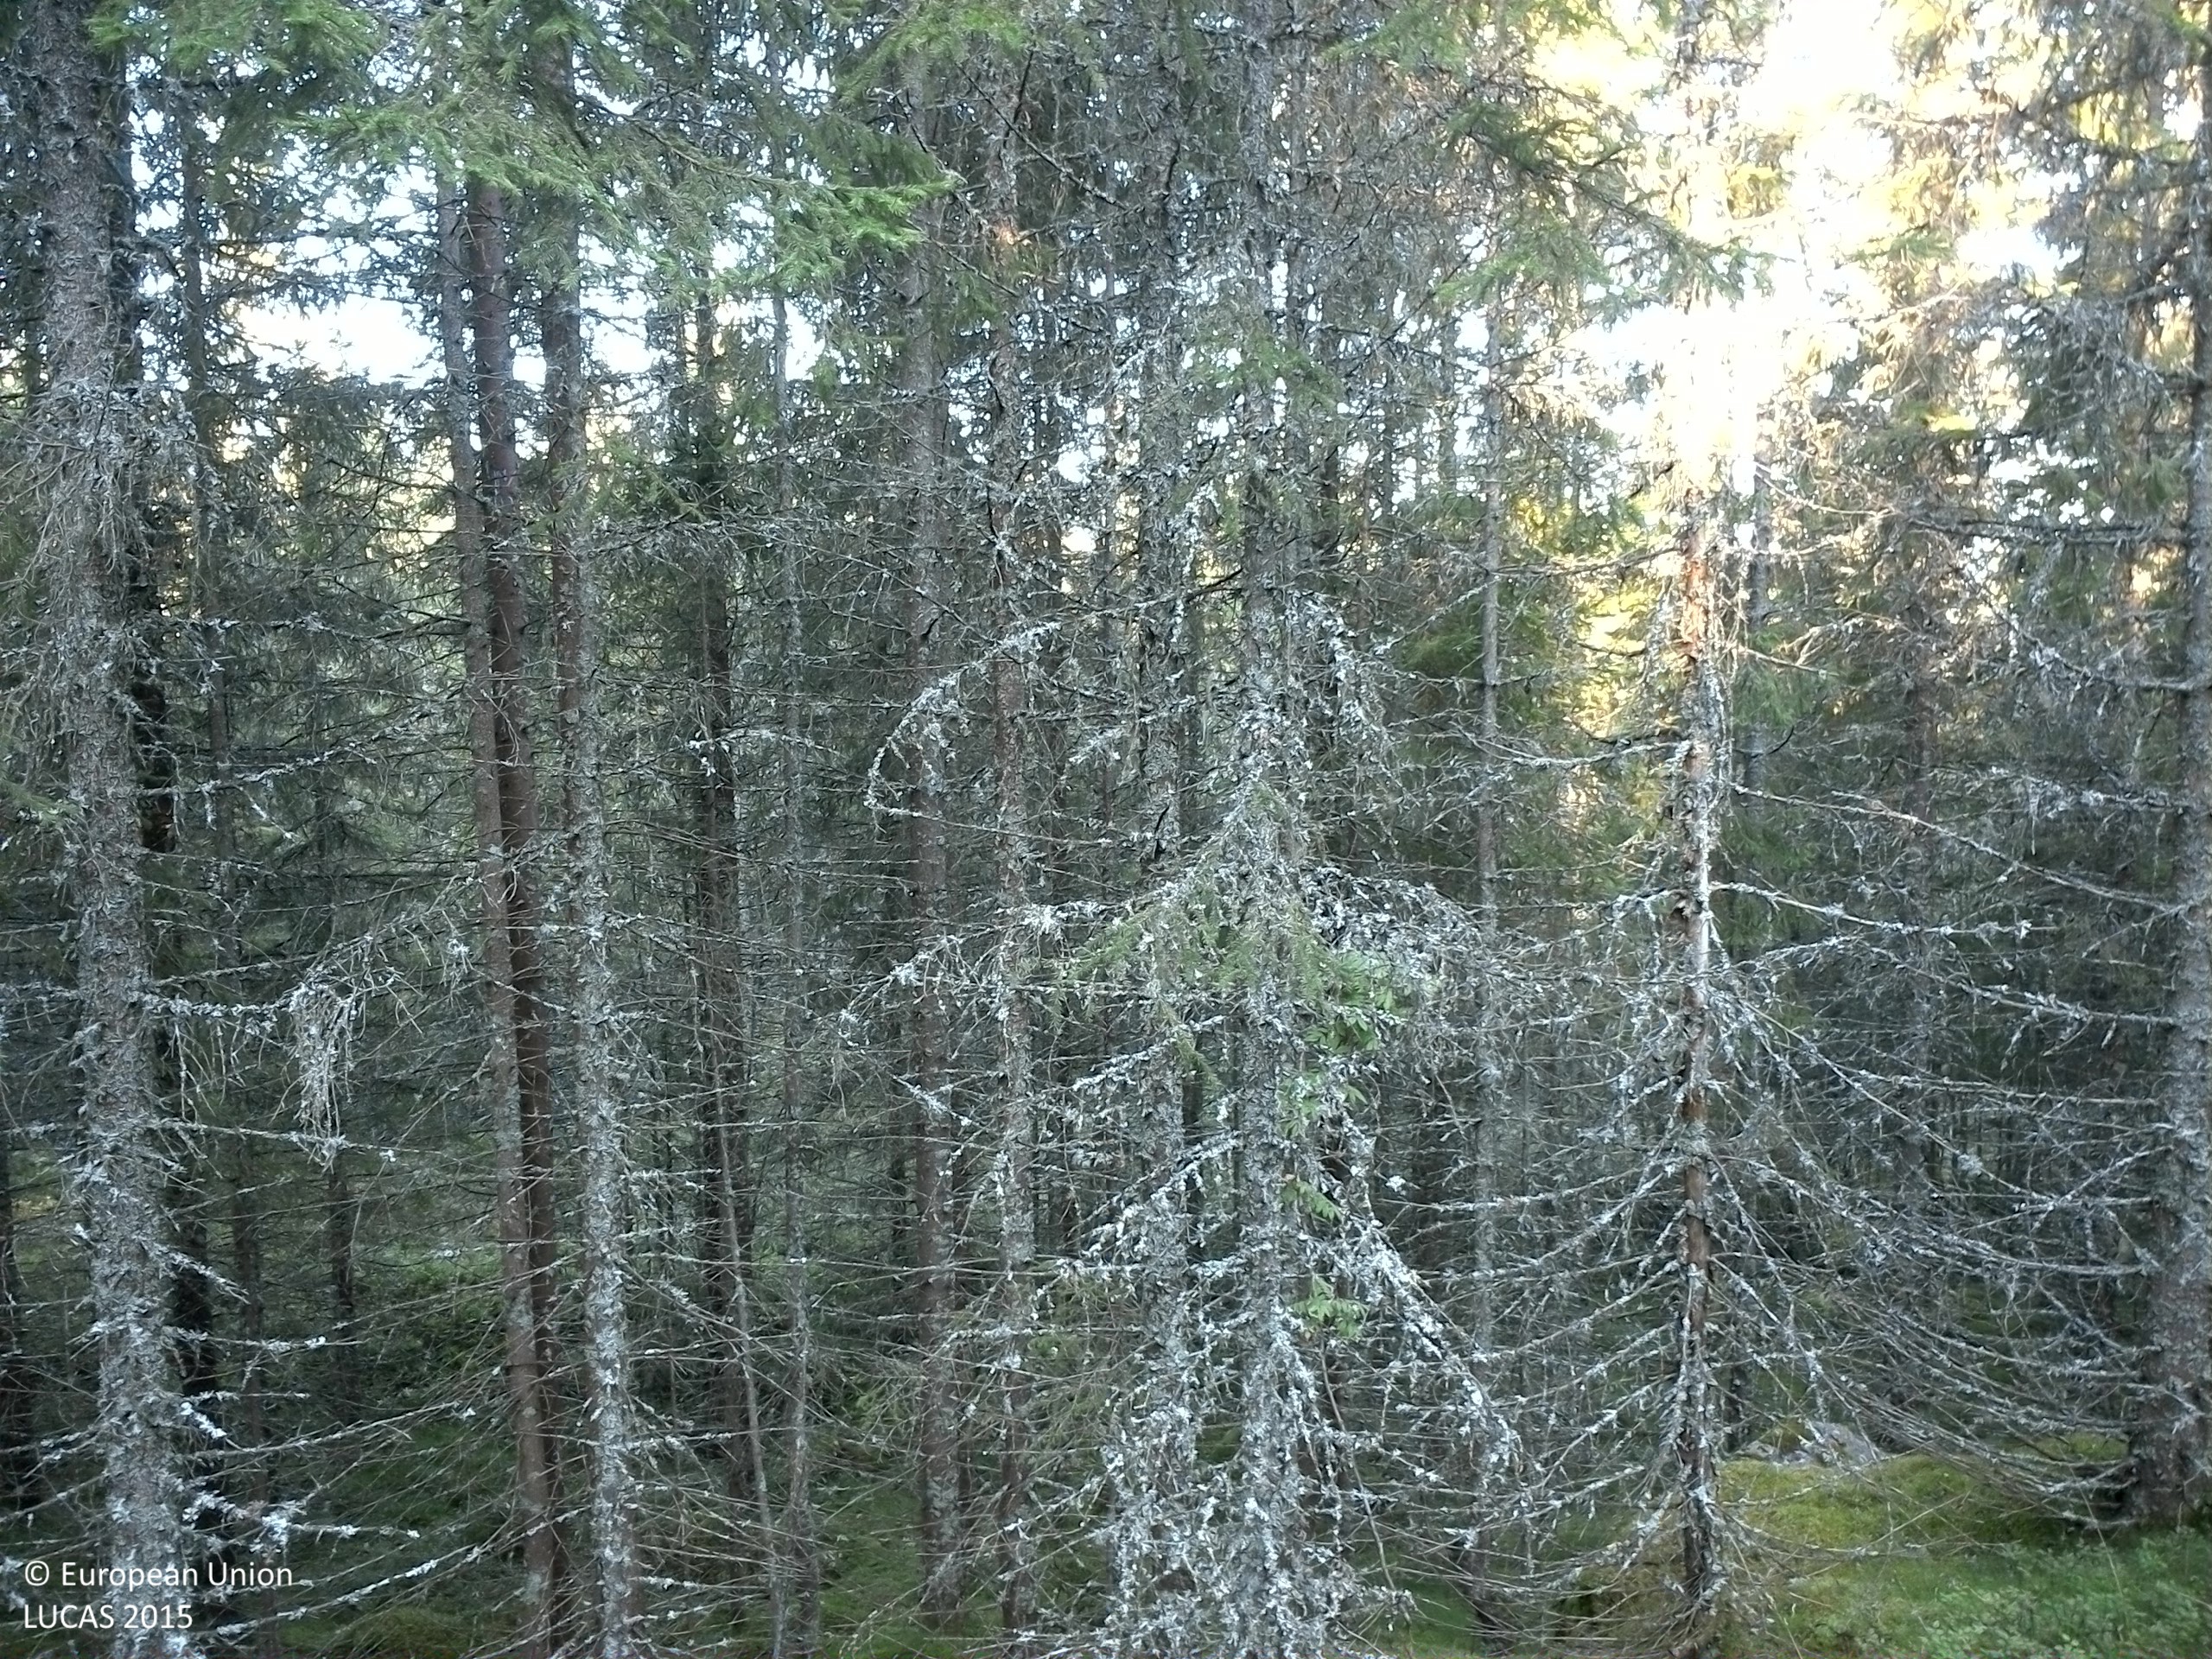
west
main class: Woodland
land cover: Spruce dominated coniferous woodland
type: boreal forest
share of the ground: 50 - 75 %
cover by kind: coniferous forest trees 70 %, shrubs 20 %, lichens and mosses 10 %
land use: Forestry
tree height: > 5 m
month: September
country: SE
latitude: 59.8694
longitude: 13.4025
